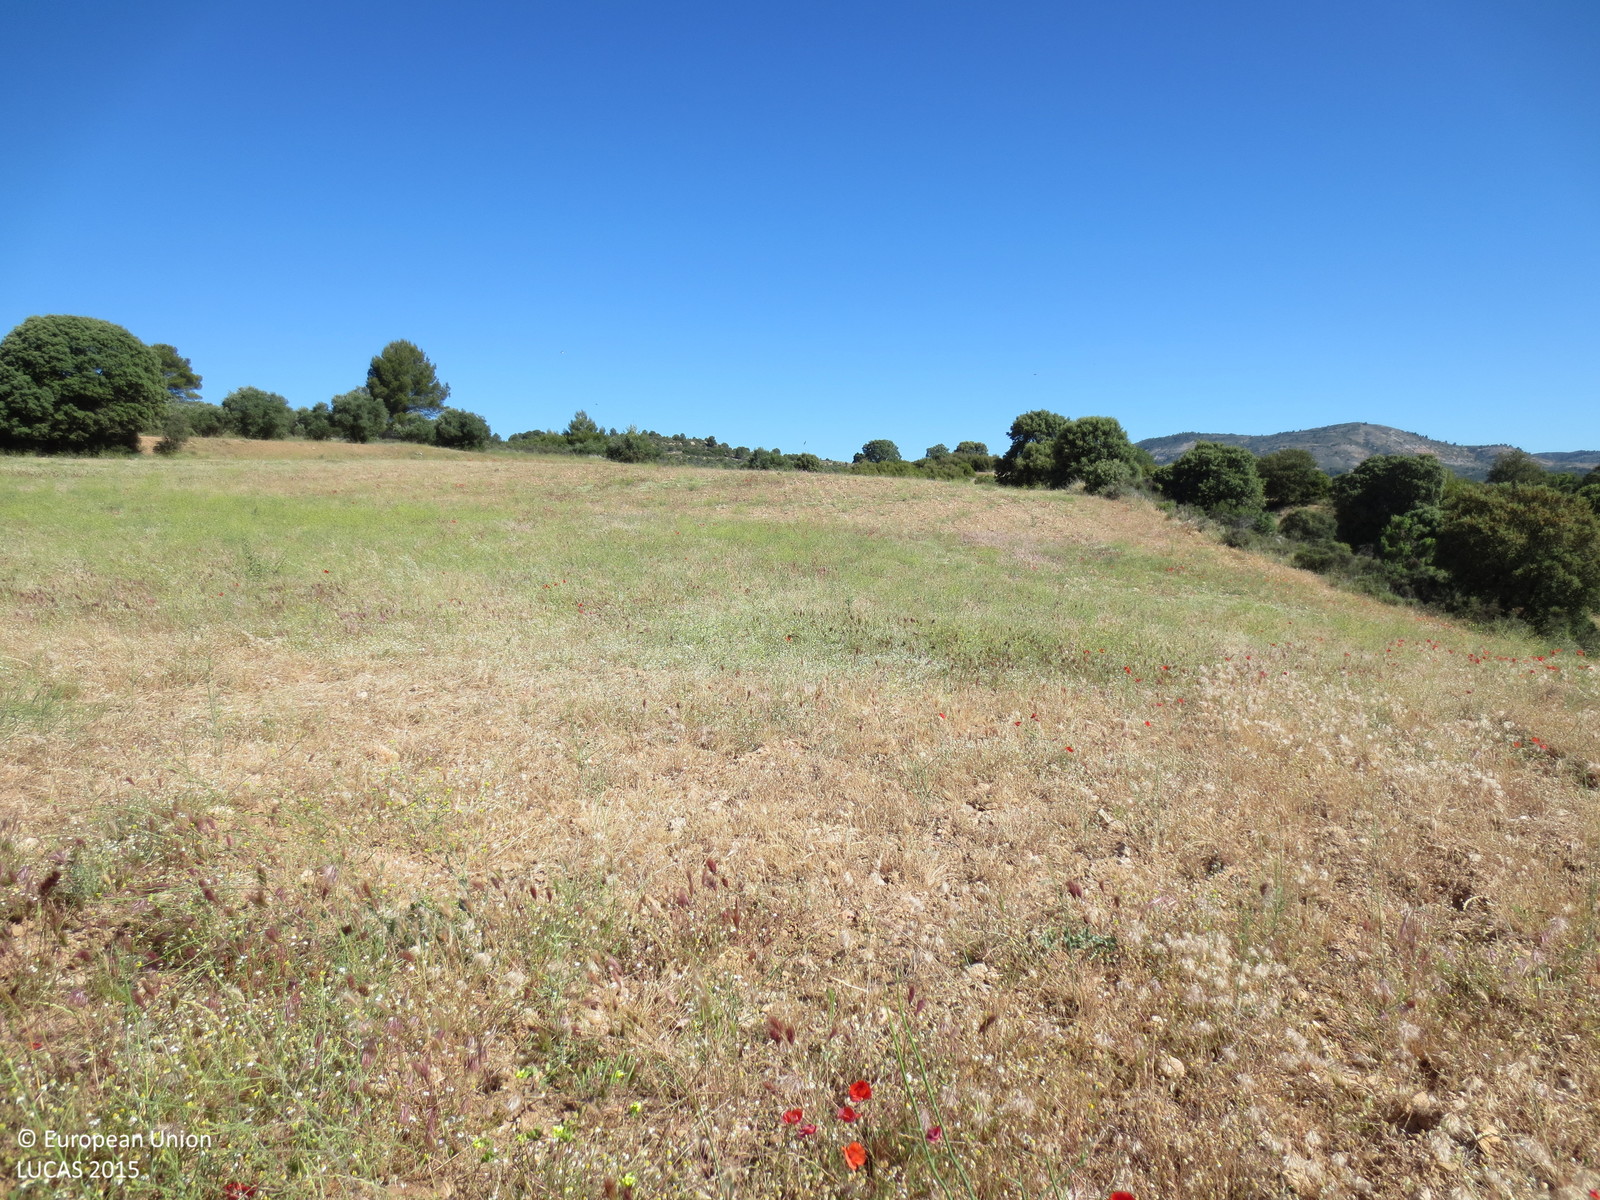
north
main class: Grassland
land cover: Spontaneously vegetated surfaces
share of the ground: 50 - 75 %
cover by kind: herbaceous plants 60 %, unconsolidated bare surface 40 %
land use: Fallow land
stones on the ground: > 50 %
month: May
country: ES
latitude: 40.4885
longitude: -2.7806
